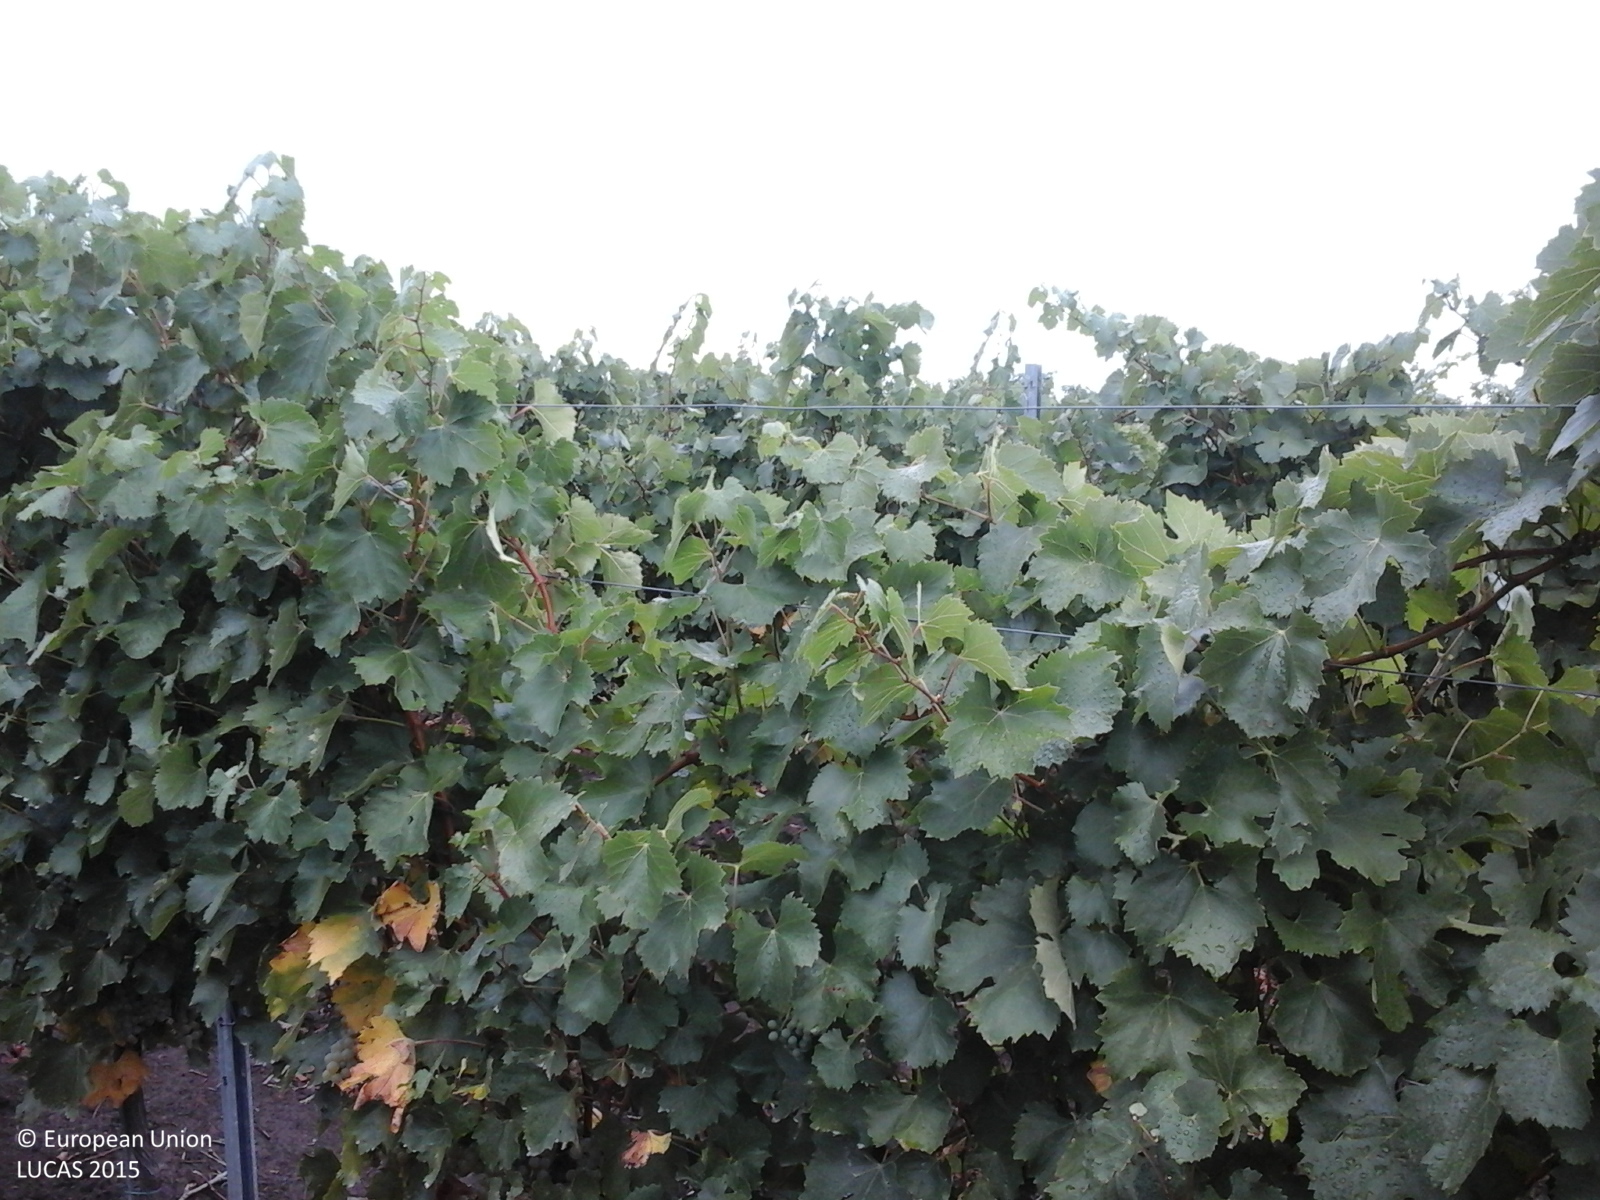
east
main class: Cropland
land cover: Vineyards
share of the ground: 50 - 75 %
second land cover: Other bare soil
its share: > 75 %
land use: Agriculture (excluding fallow land and kitchen gardens)
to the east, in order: Vineyards; Other bare soil; Tracks; Vineyards; Spontaneously vegetated surfaces; Paved roads, cycling and walking lanes; Grass margins; Vineyards
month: August
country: RO
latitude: 45.8372
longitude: 21.5057
